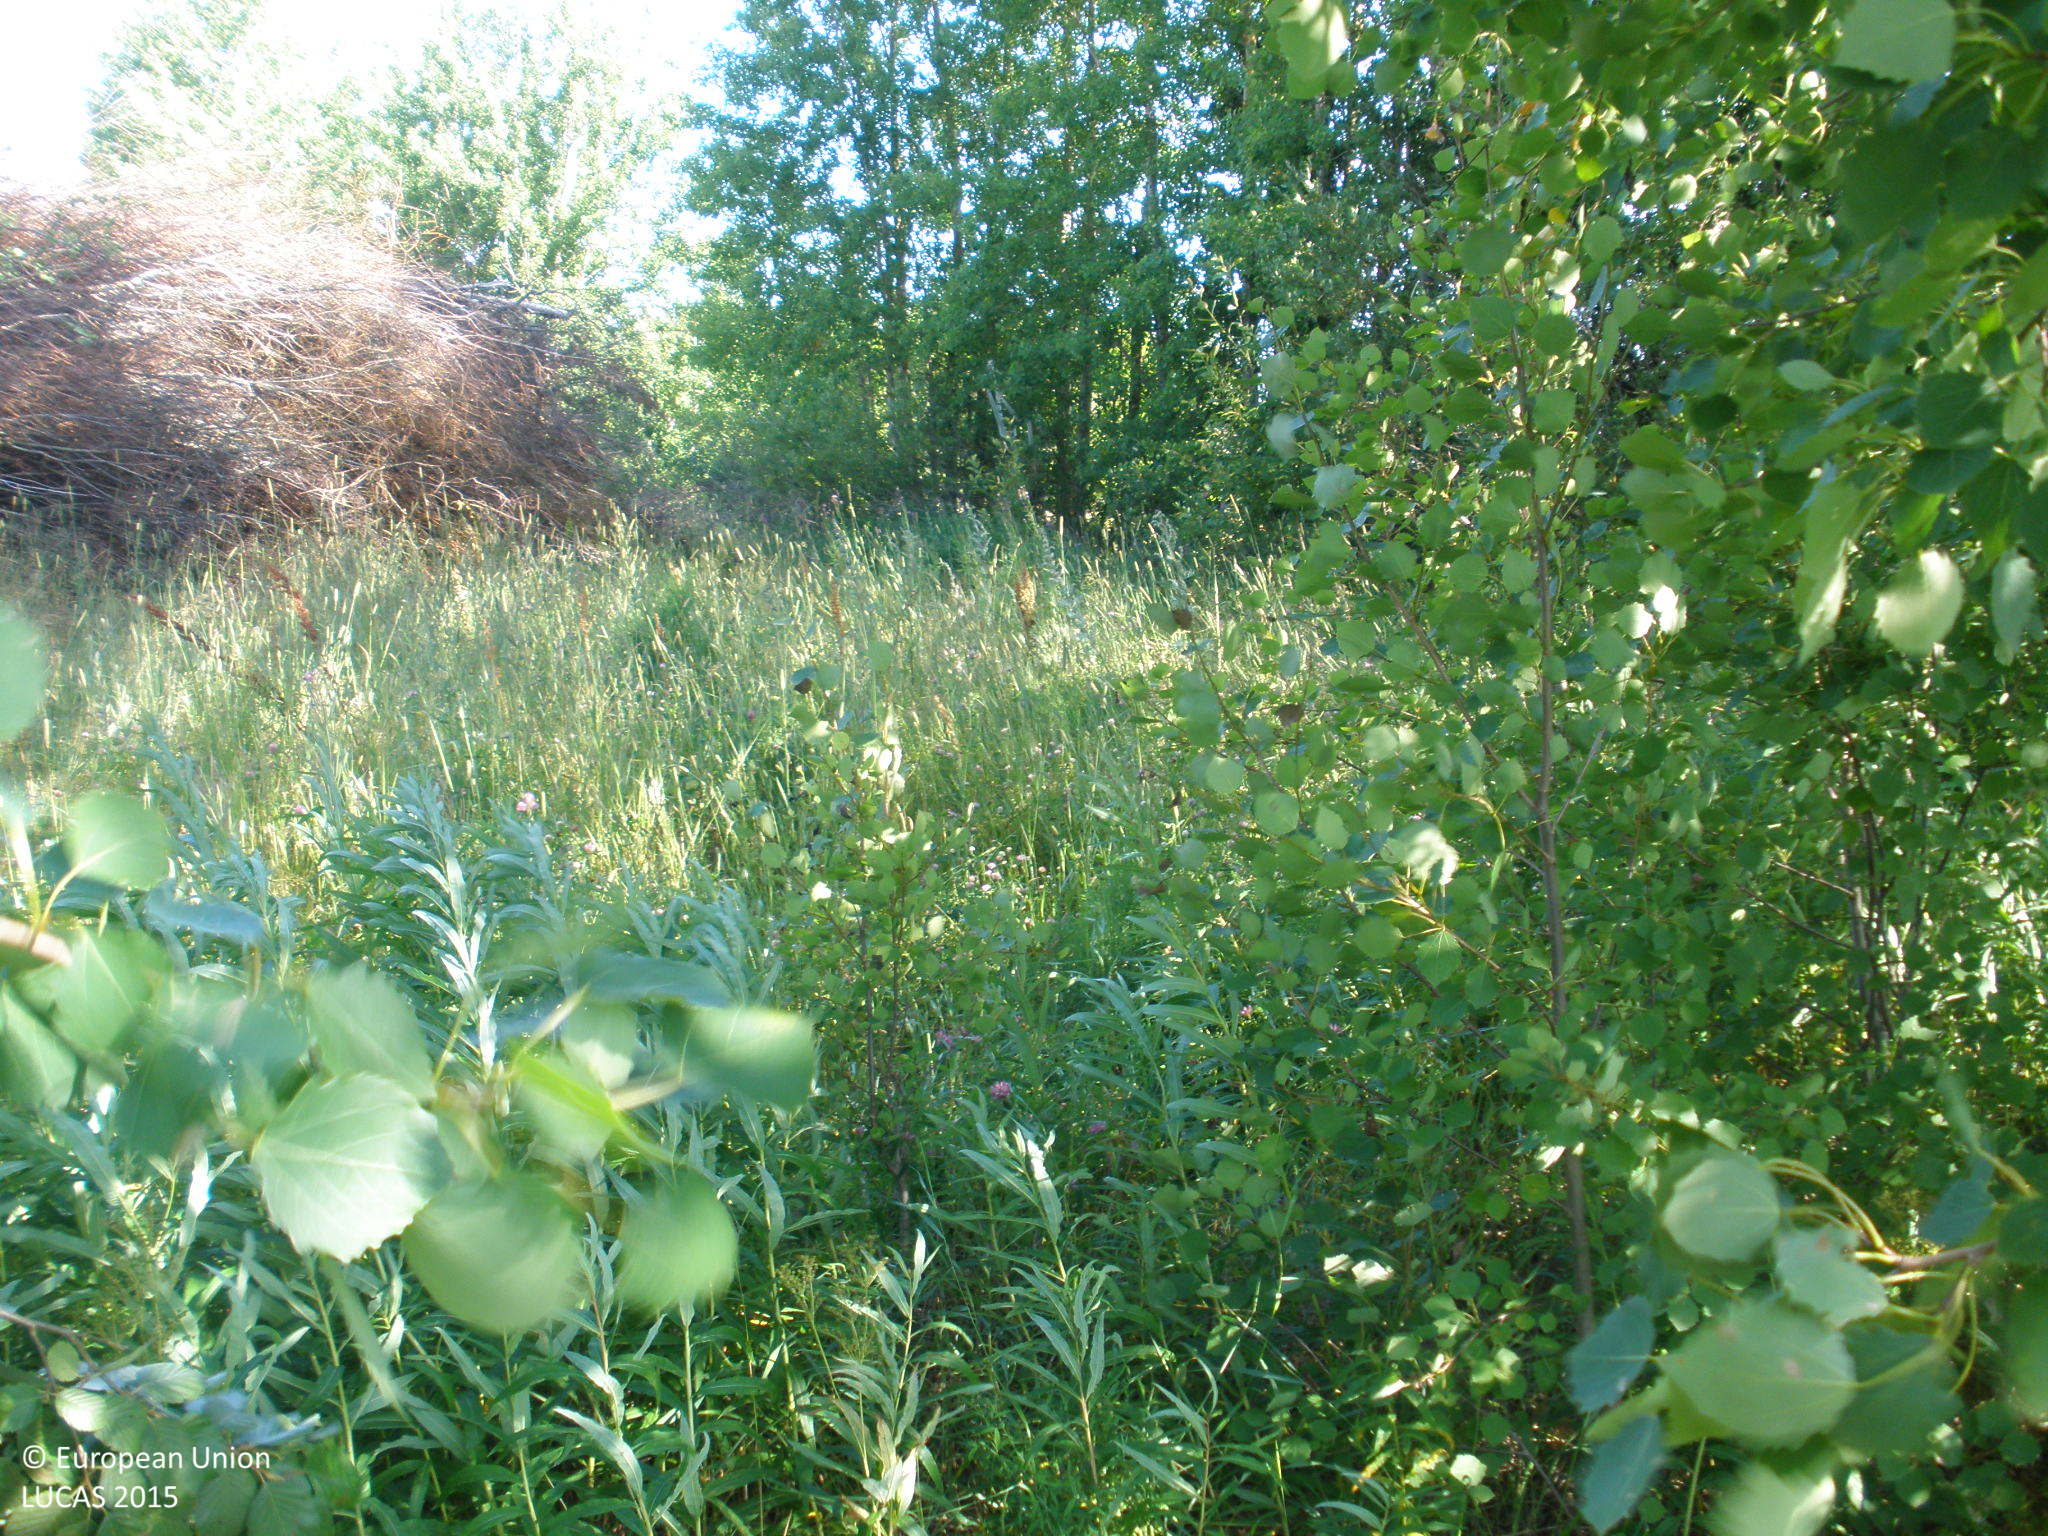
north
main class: Cropland
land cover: Oats
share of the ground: 50 - 75 %
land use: Agriculture (excluding fallow land and kitchen gardens)
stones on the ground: < 10 %
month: August
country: FI
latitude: 60.6614
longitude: 23.1245
